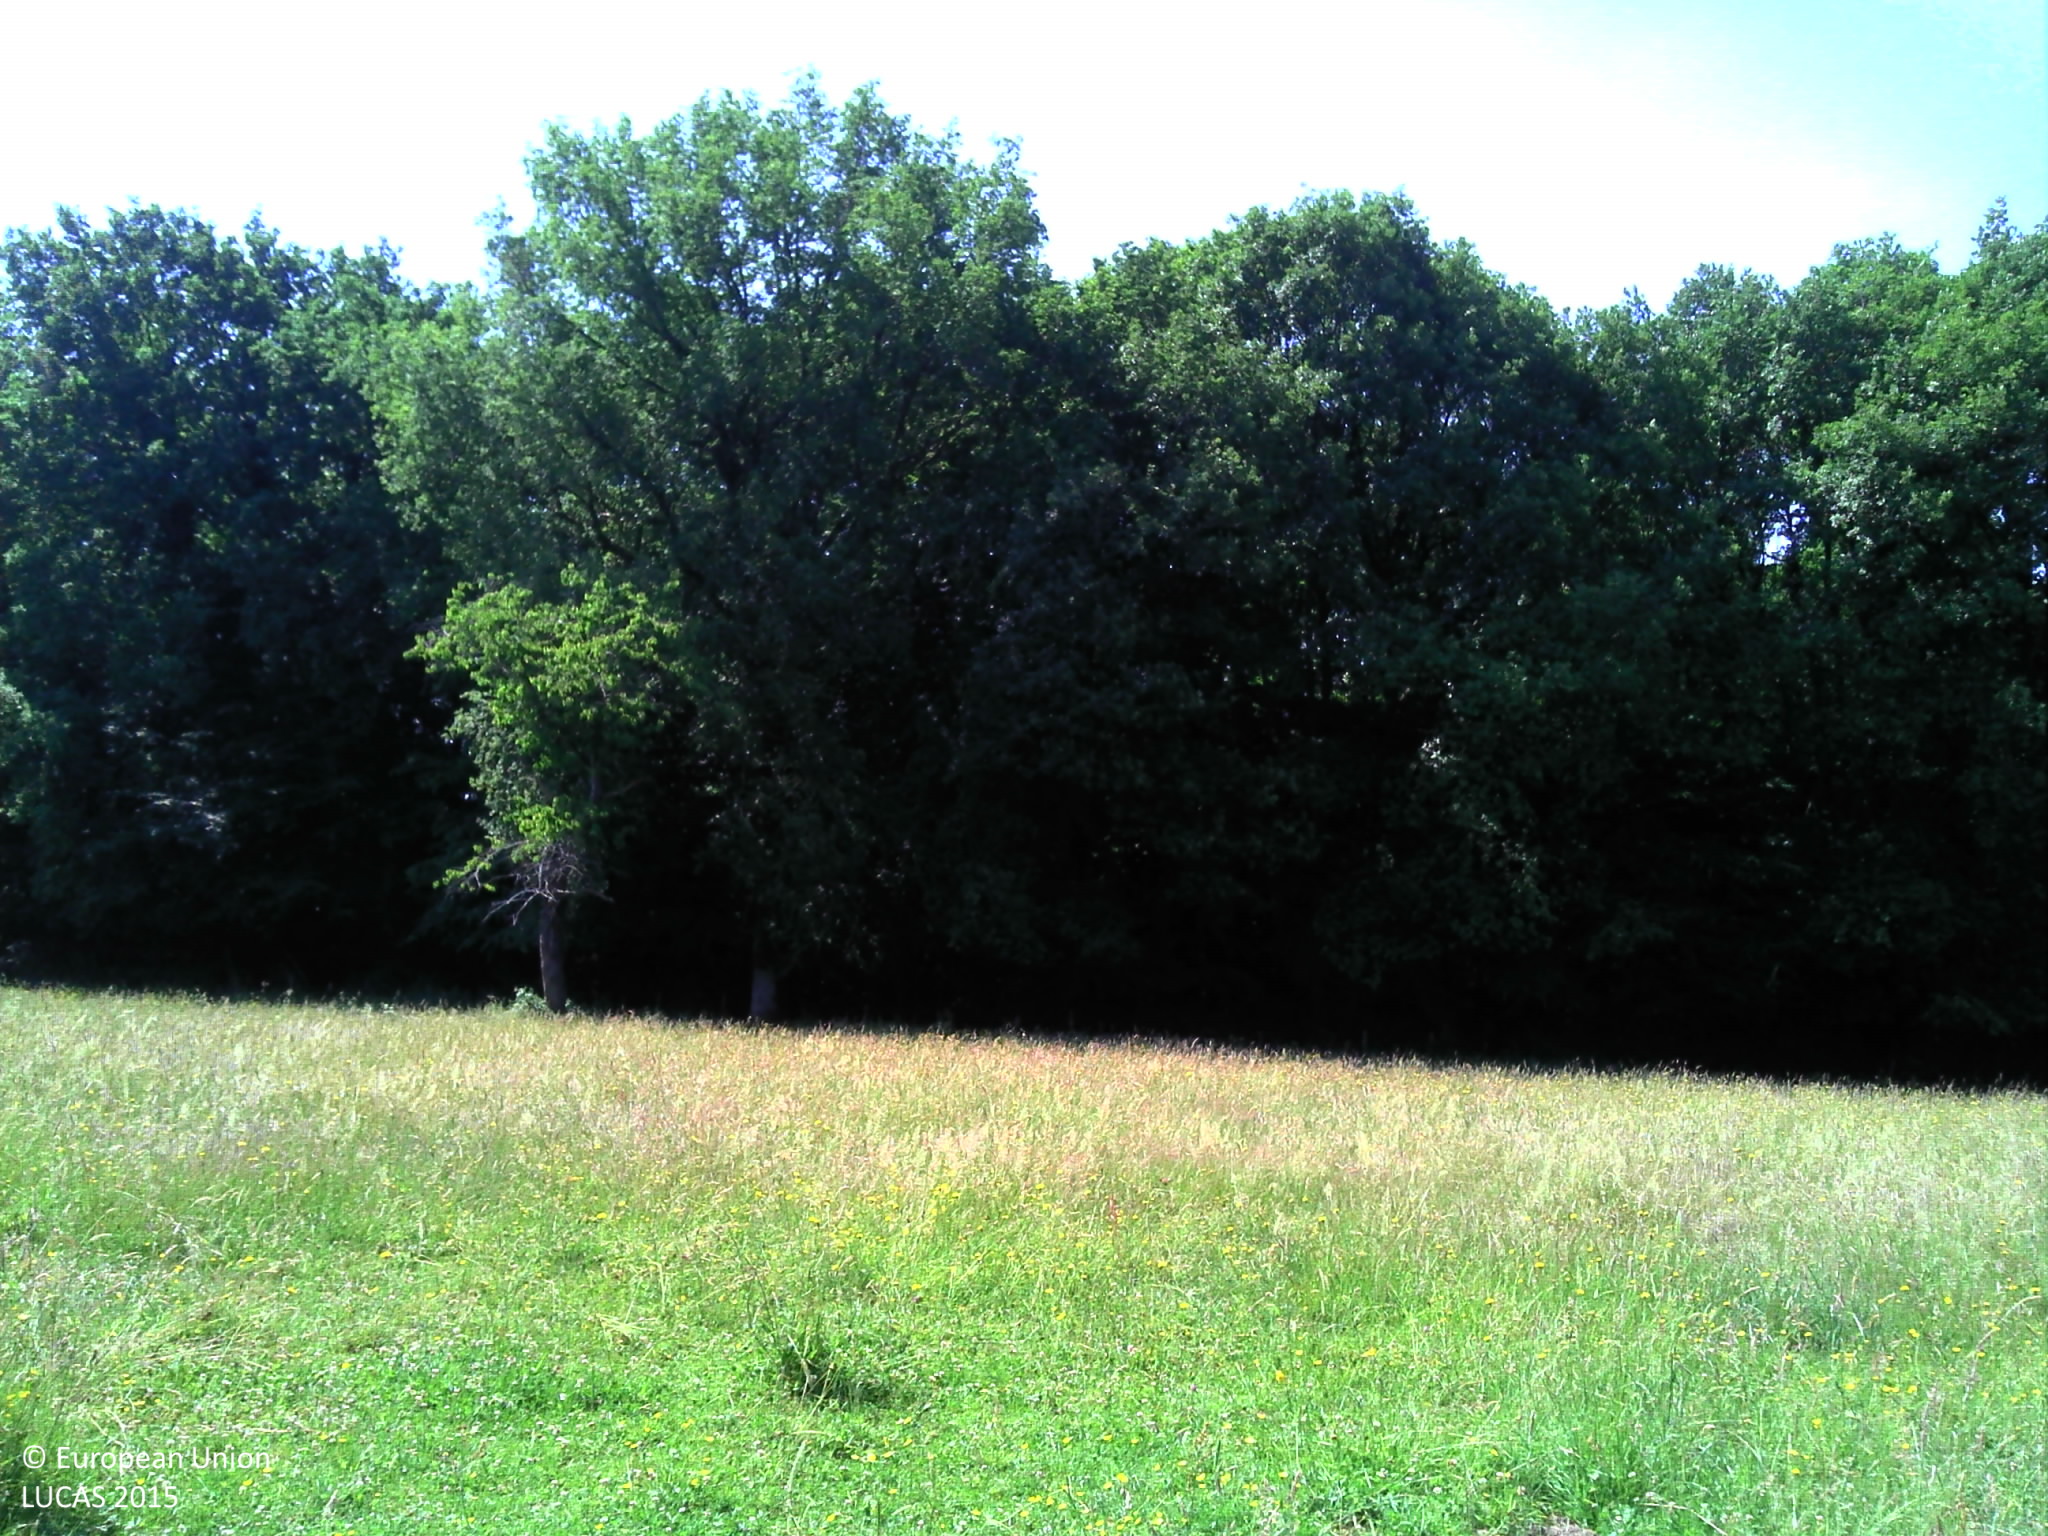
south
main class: Grassland
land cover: Grassland without tree/shrub cover
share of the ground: > 75 %
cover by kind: herbaceous plants 100 %
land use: Agriculture (excluding fallow land and kitchen gardens)
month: June
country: FR
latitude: 46.2350
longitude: 2.8003
